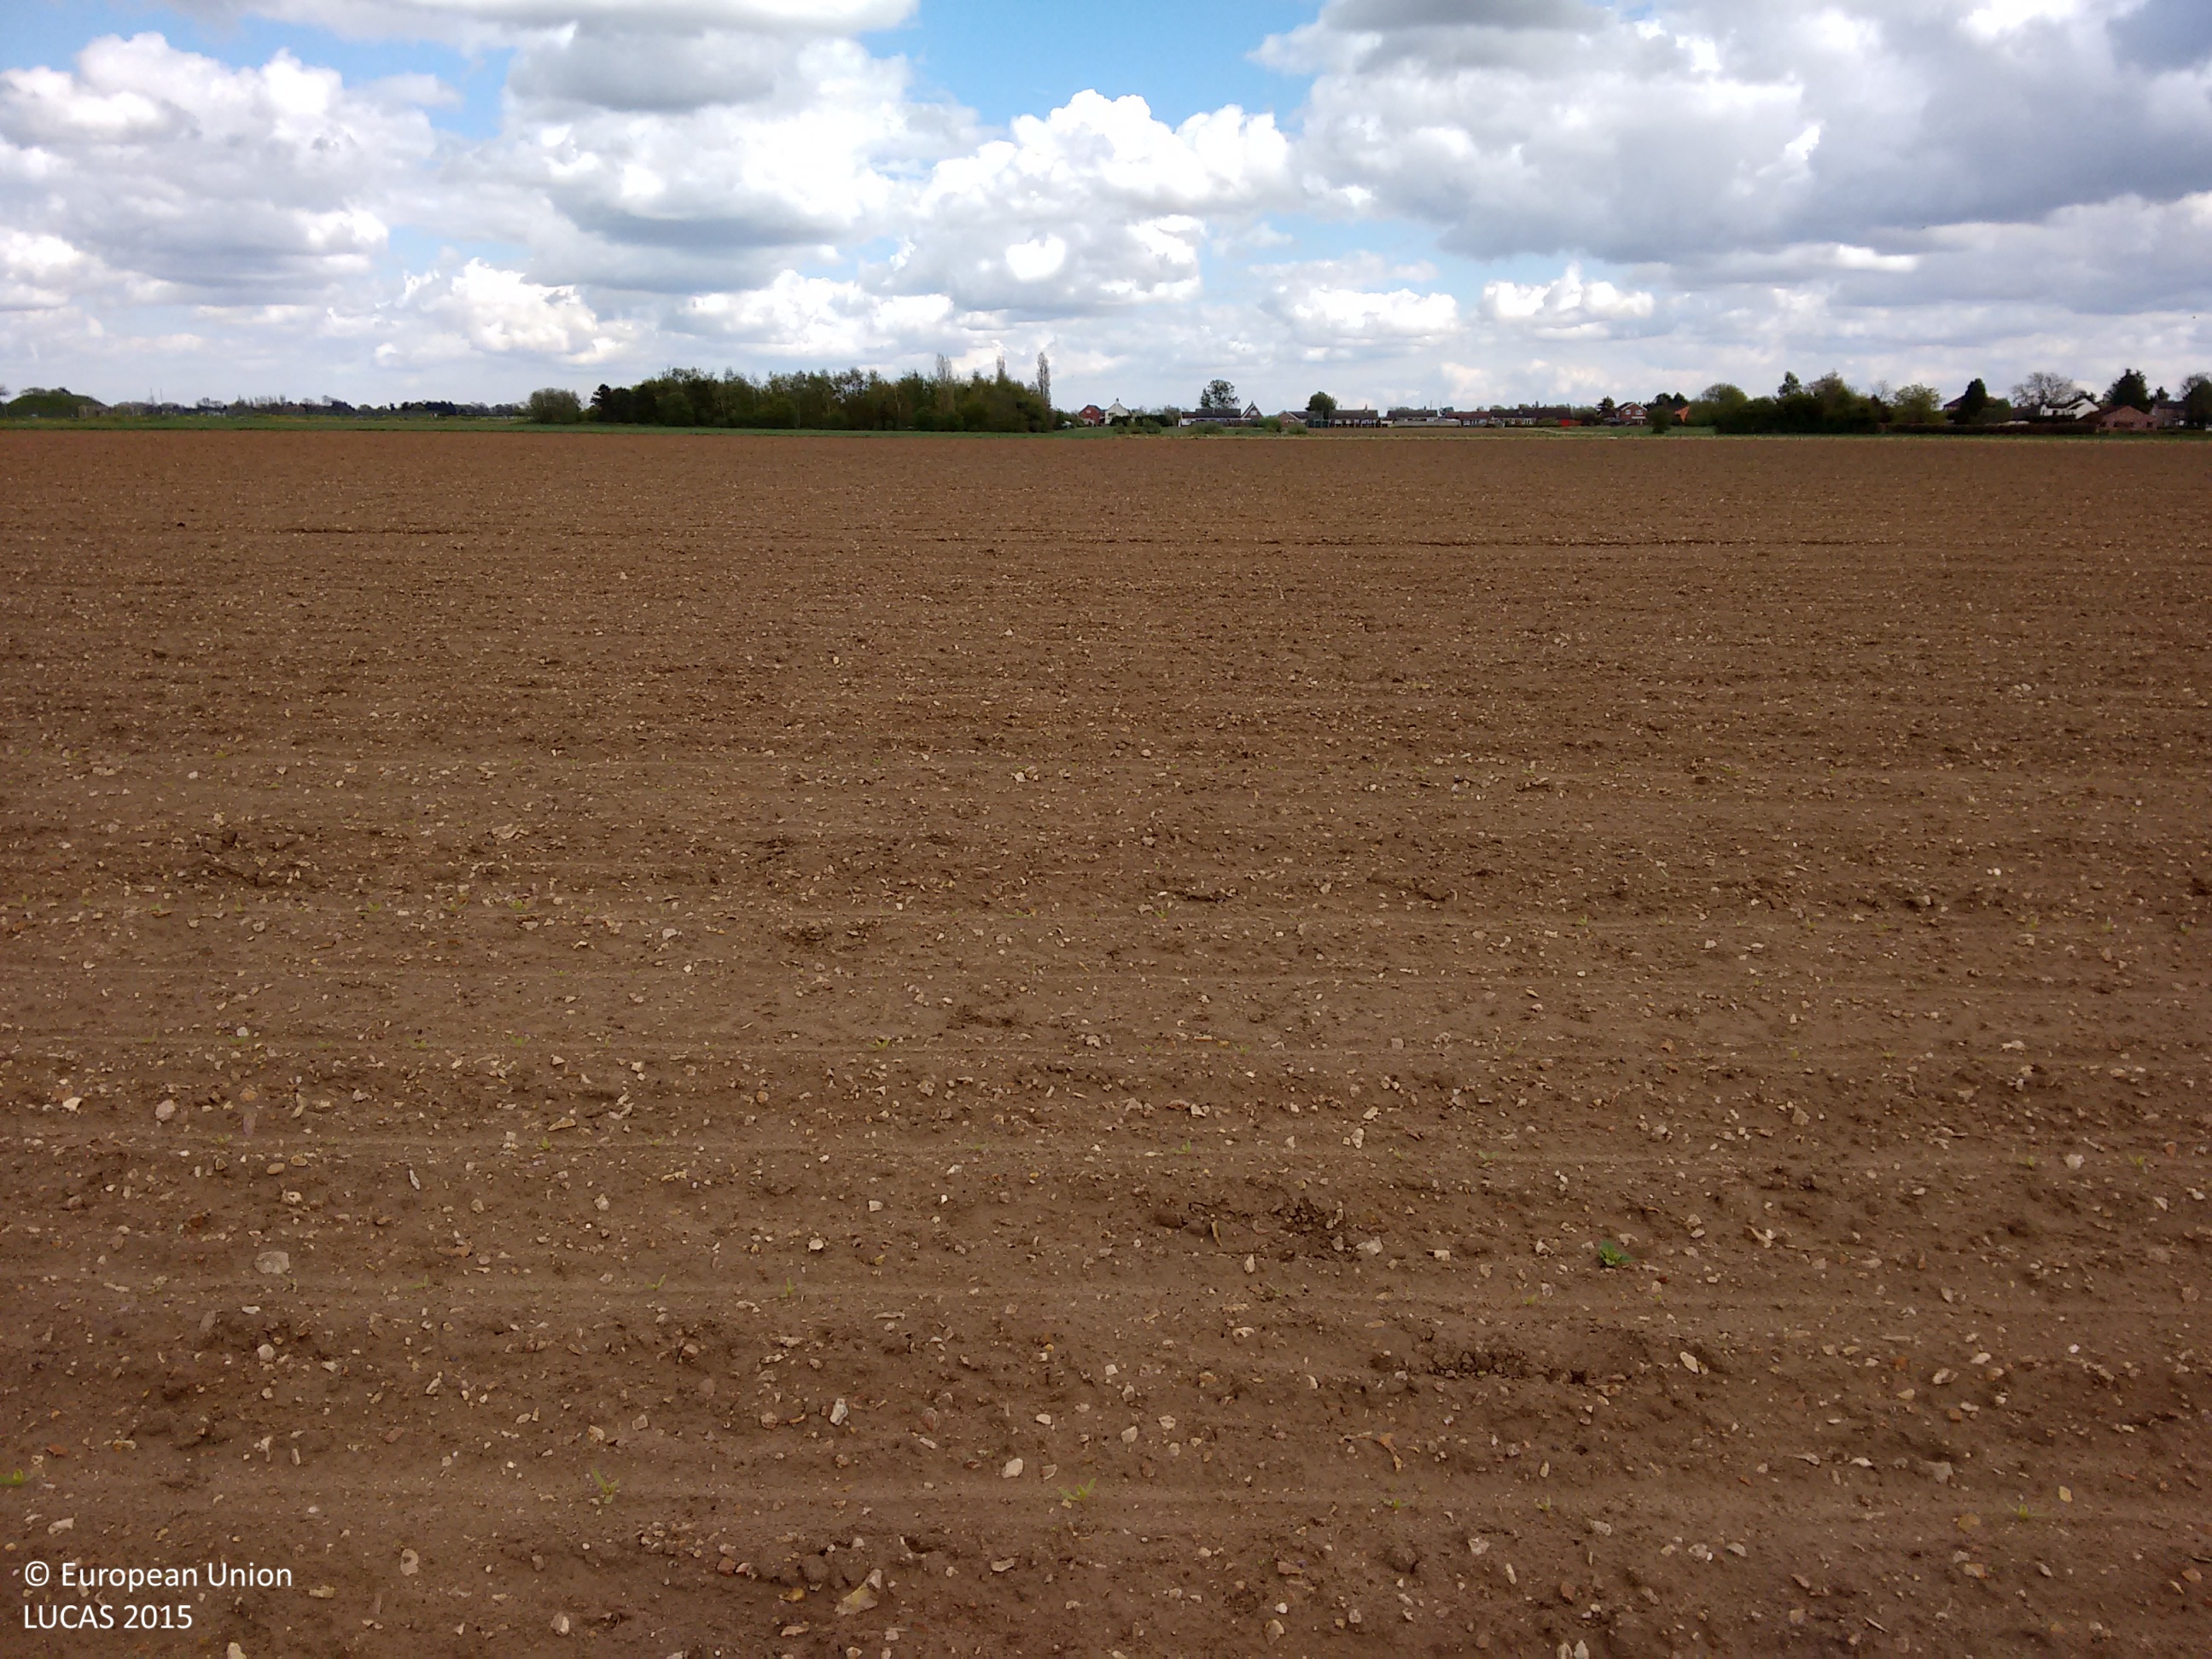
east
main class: Cropland
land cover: Other fresh vegetables
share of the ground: < 10 %
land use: Agriculture (excluding fallow land and kitchen gardens)
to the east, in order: Other fresh vegetables; Other bare soil; Common wheat
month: April
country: GB
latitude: 53.0814
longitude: -0.1705
